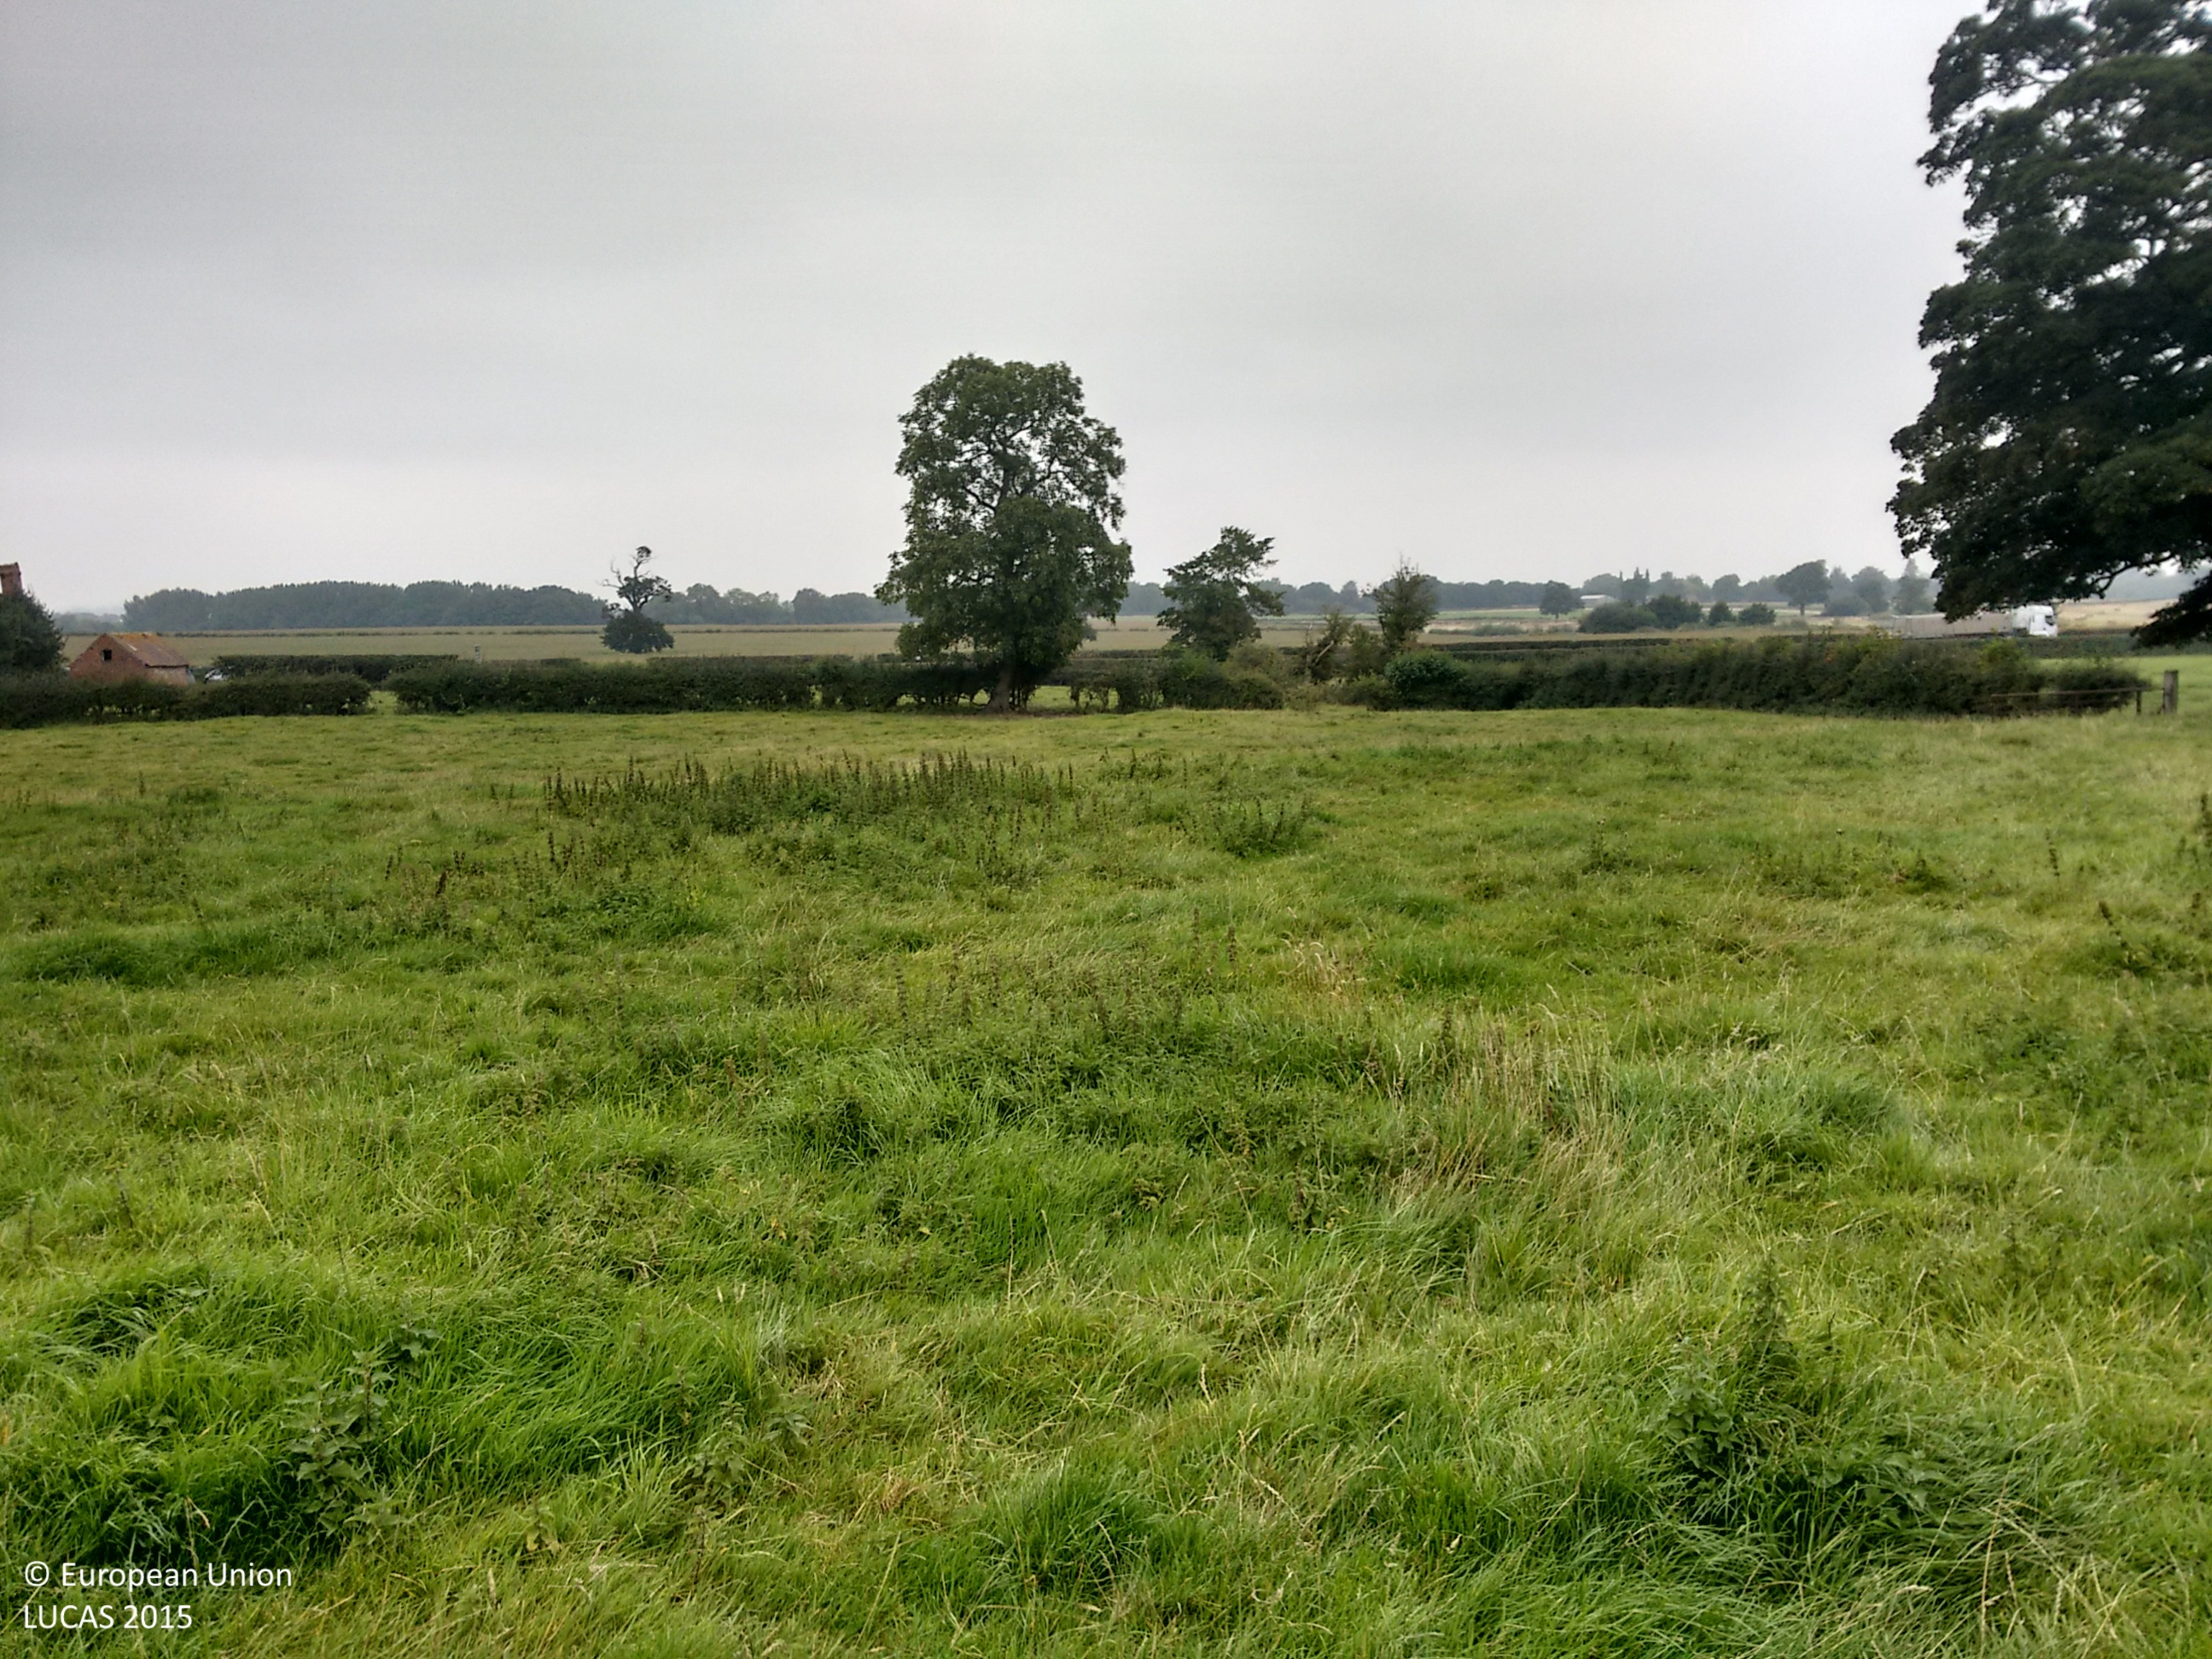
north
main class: Grassland
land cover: Grassland without tree/shrub cover
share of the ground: > 75 %
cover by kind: herbaceous plants 100 %
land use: Agriculture (excluding fallow land and kitchen gardens)
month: September
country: GB
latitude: 52.7140
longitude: -2.8470
